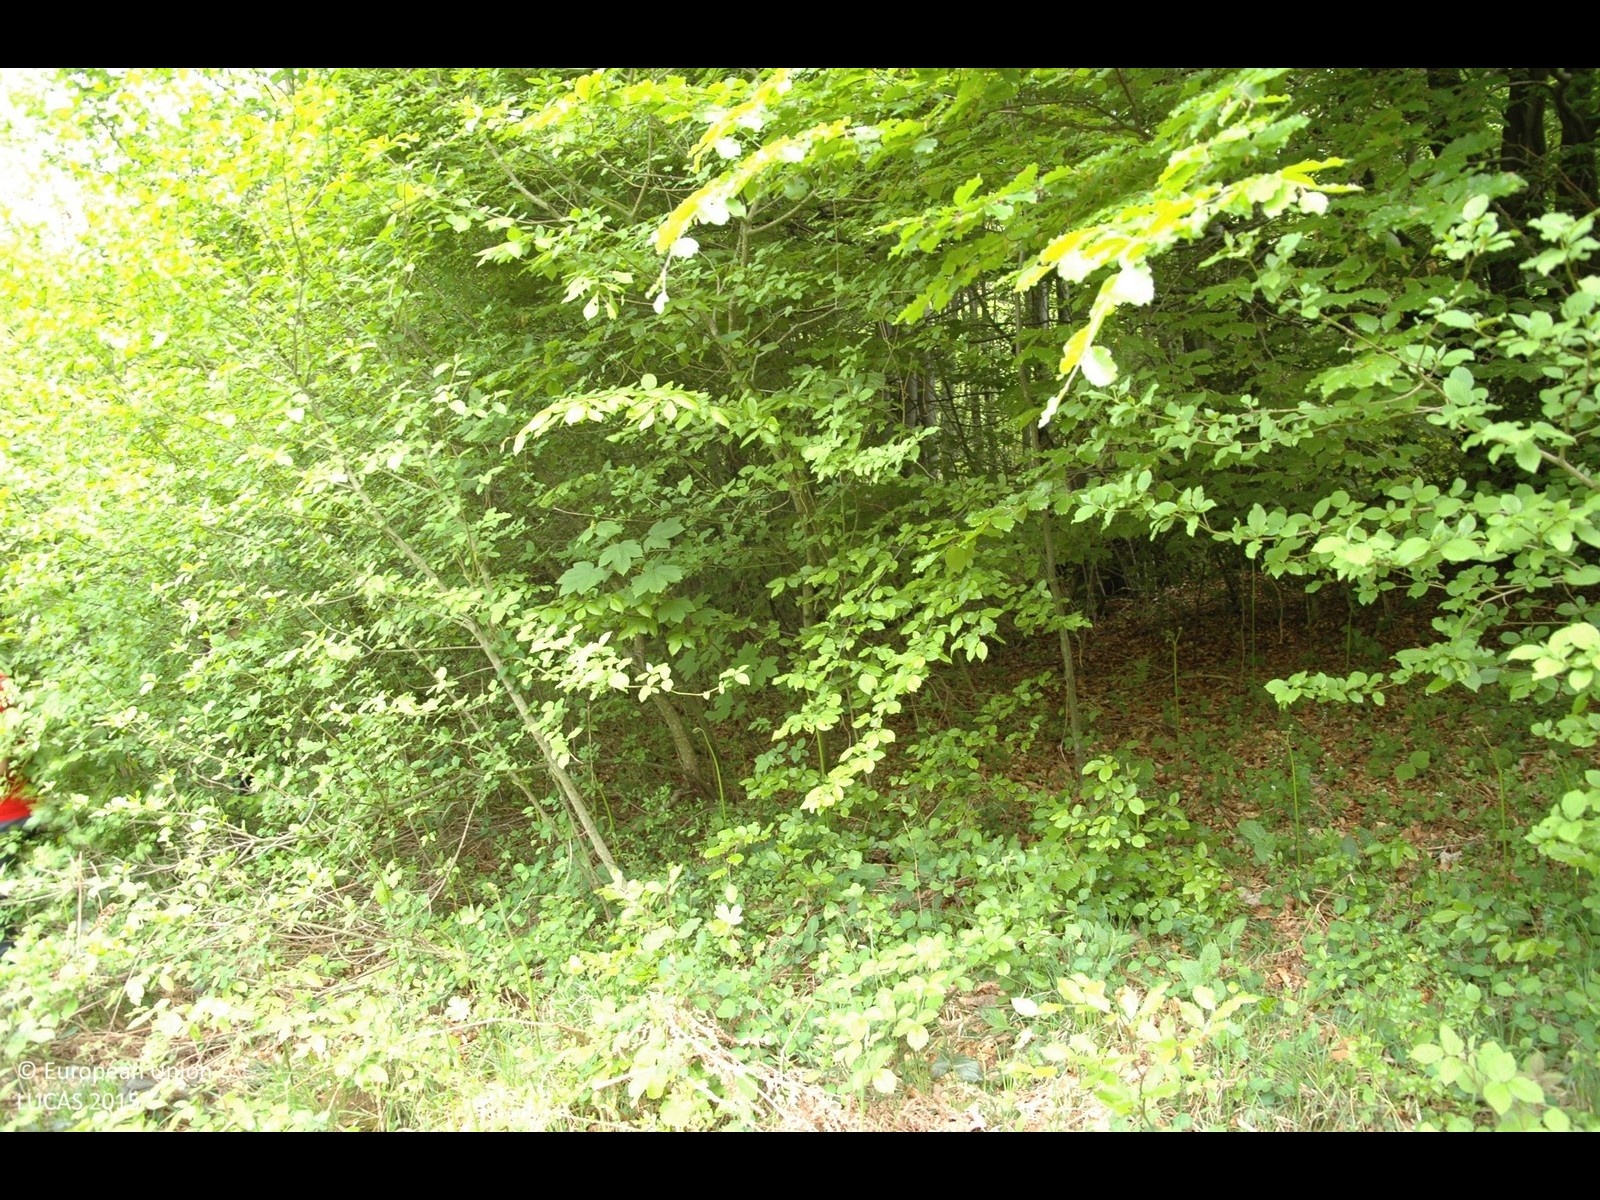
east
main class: Shrubland
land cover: Shrubland without tree cover
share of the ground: > 75 %
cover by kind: shrubs 90 %, herbaceous plants 10 %
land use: Semi-natural and natural areas not in use
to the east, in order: Shrubland without tree cover; Broadleaved woodland; Grassland without tree/shrub cover; Broadleaved woodland; Tracks; Grassland without tree/shrub cover; Clovers; Grassland without tree/shrub cover; Shruby margins; Clovers; Spontaneously vegetated surfaces
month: May
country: HR
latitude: 45.8049
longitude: 15.6460
